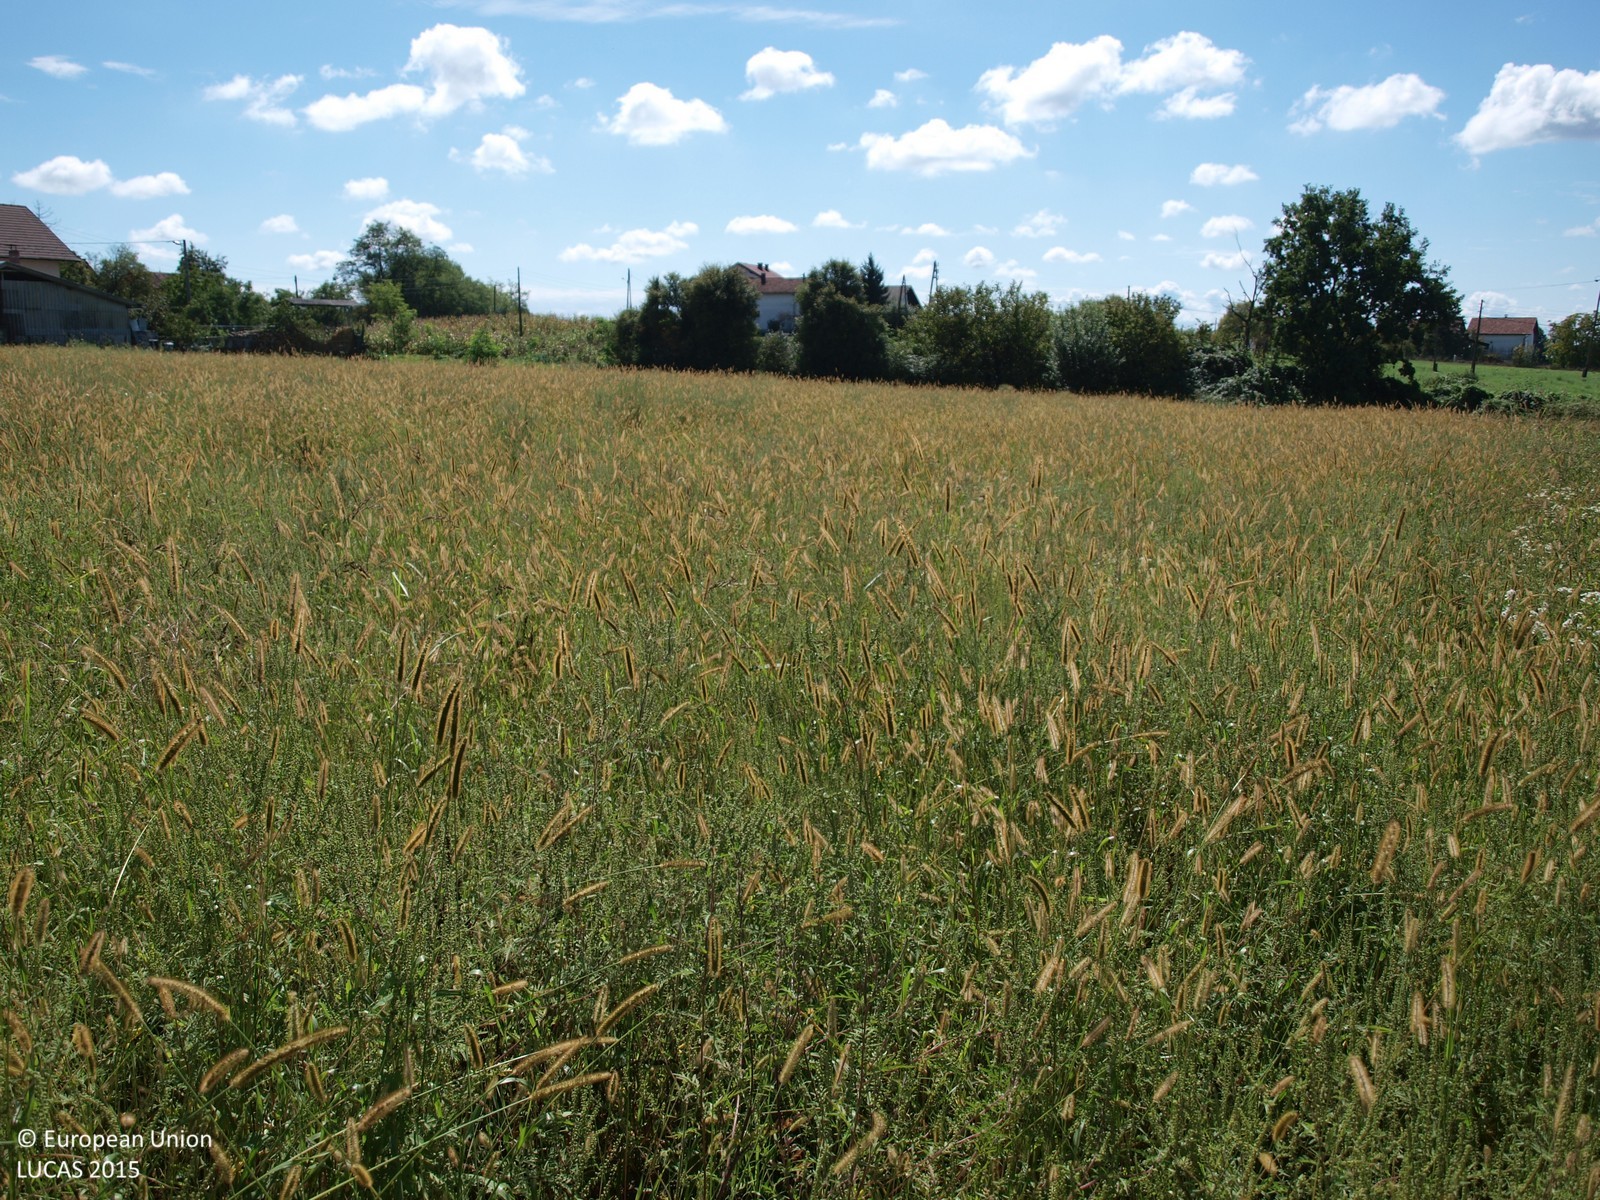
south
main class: Grassland
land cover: Grassland without tree/shrub cover
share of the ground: > 75 %
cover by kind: herbaceous plants 100 %
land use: Agriculture (excluding fallow land and kitchen gardens)
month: September
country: HR
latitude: 45.7432
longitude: 16.4124
